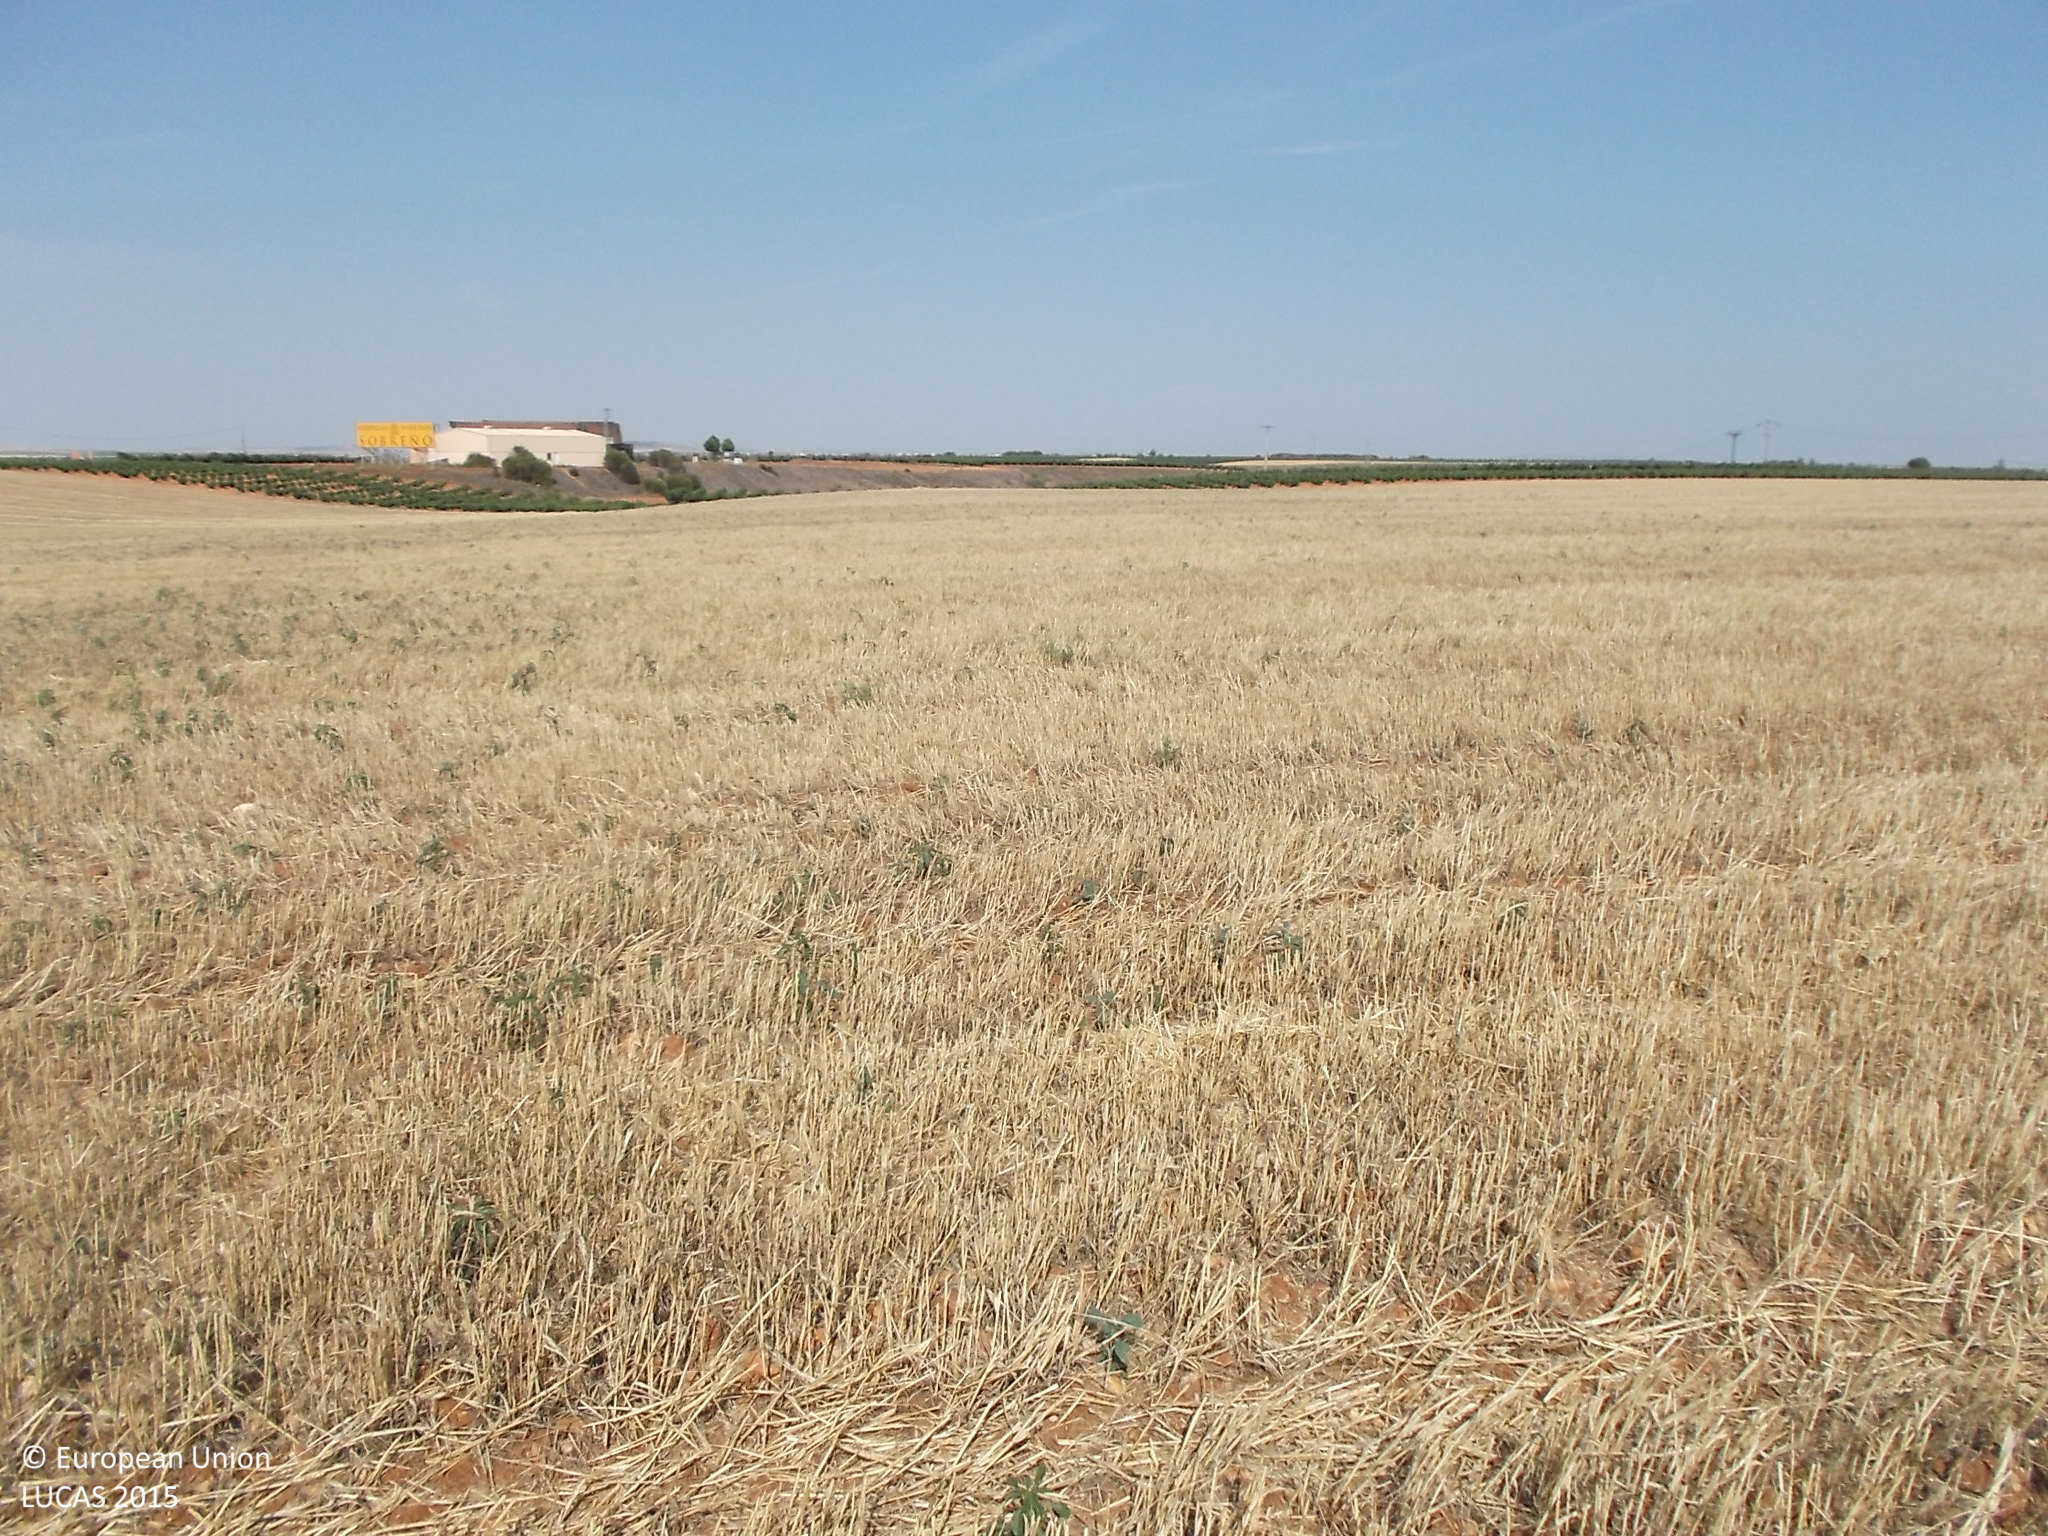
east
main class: Cropland
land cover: Barley
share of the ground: < 10 %
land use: Agriculture (excluding fallow land and kitchen gardens)
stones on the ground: < 10 %
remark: Harvested field
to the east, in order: Barley; Vineyards
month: July
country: ES
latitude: 41.5294
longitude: -5.3599
